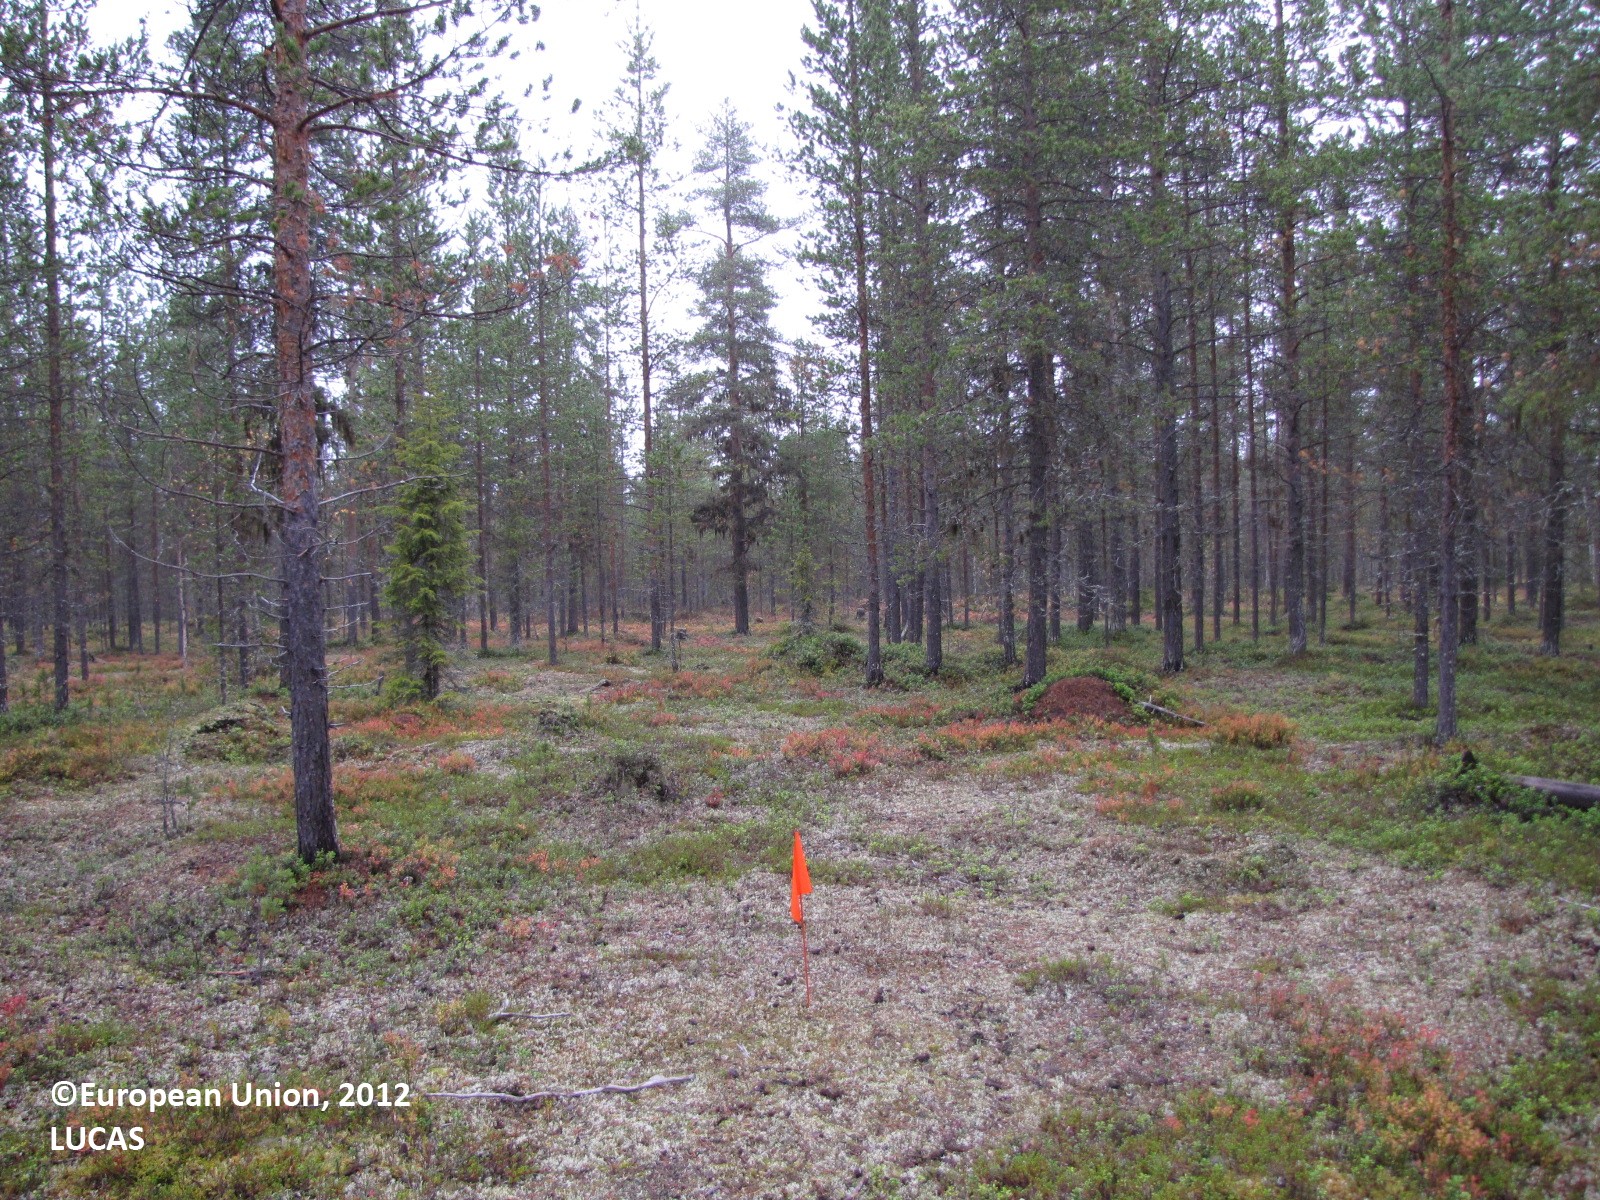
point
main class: Woodland
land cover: Pine dominated coniferous woodland
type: boreal forest
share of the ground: 25 - 50 %
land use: Forestry
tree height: > 5 m
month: September
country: FI
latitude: 67.4132
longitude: 24.1416
